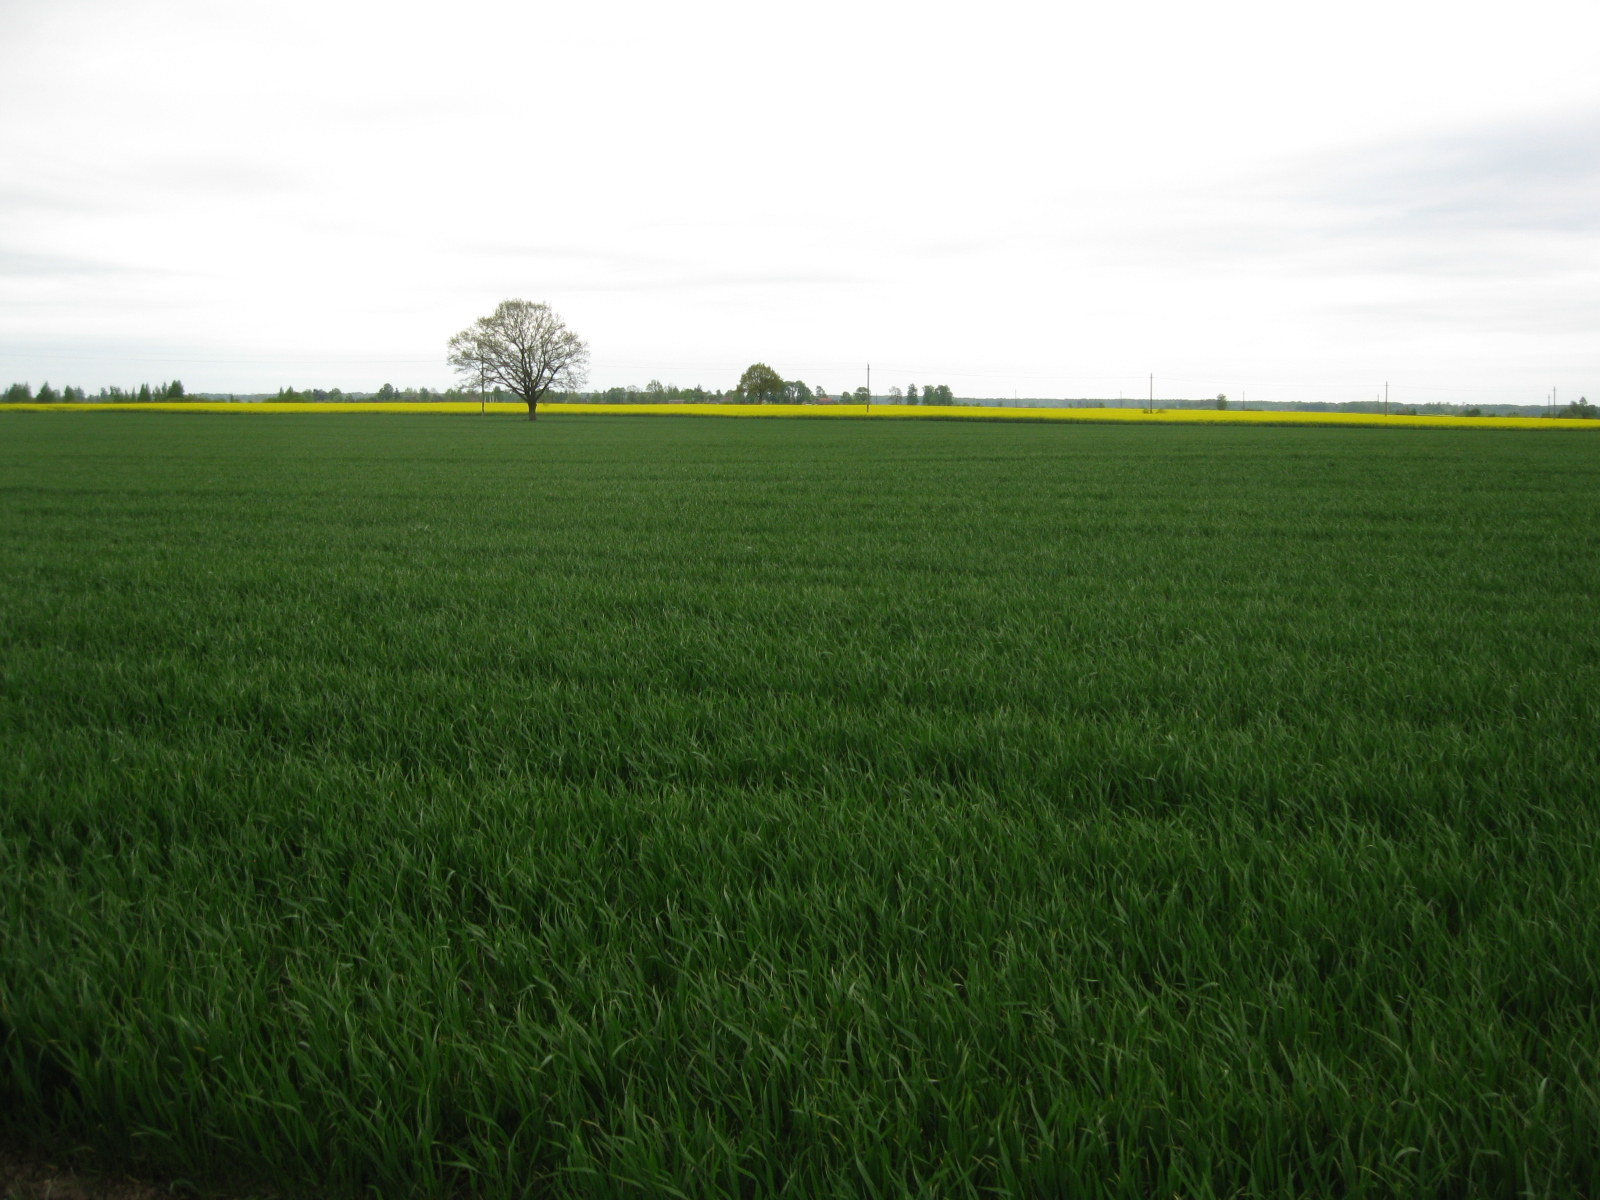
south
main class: Cropland
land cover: Common wheat
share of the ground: > 75 %
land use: Agriculture (excluding fallow land and kitchen gardens)
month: May
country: LT
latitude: 56.2453
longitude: 23.4201
